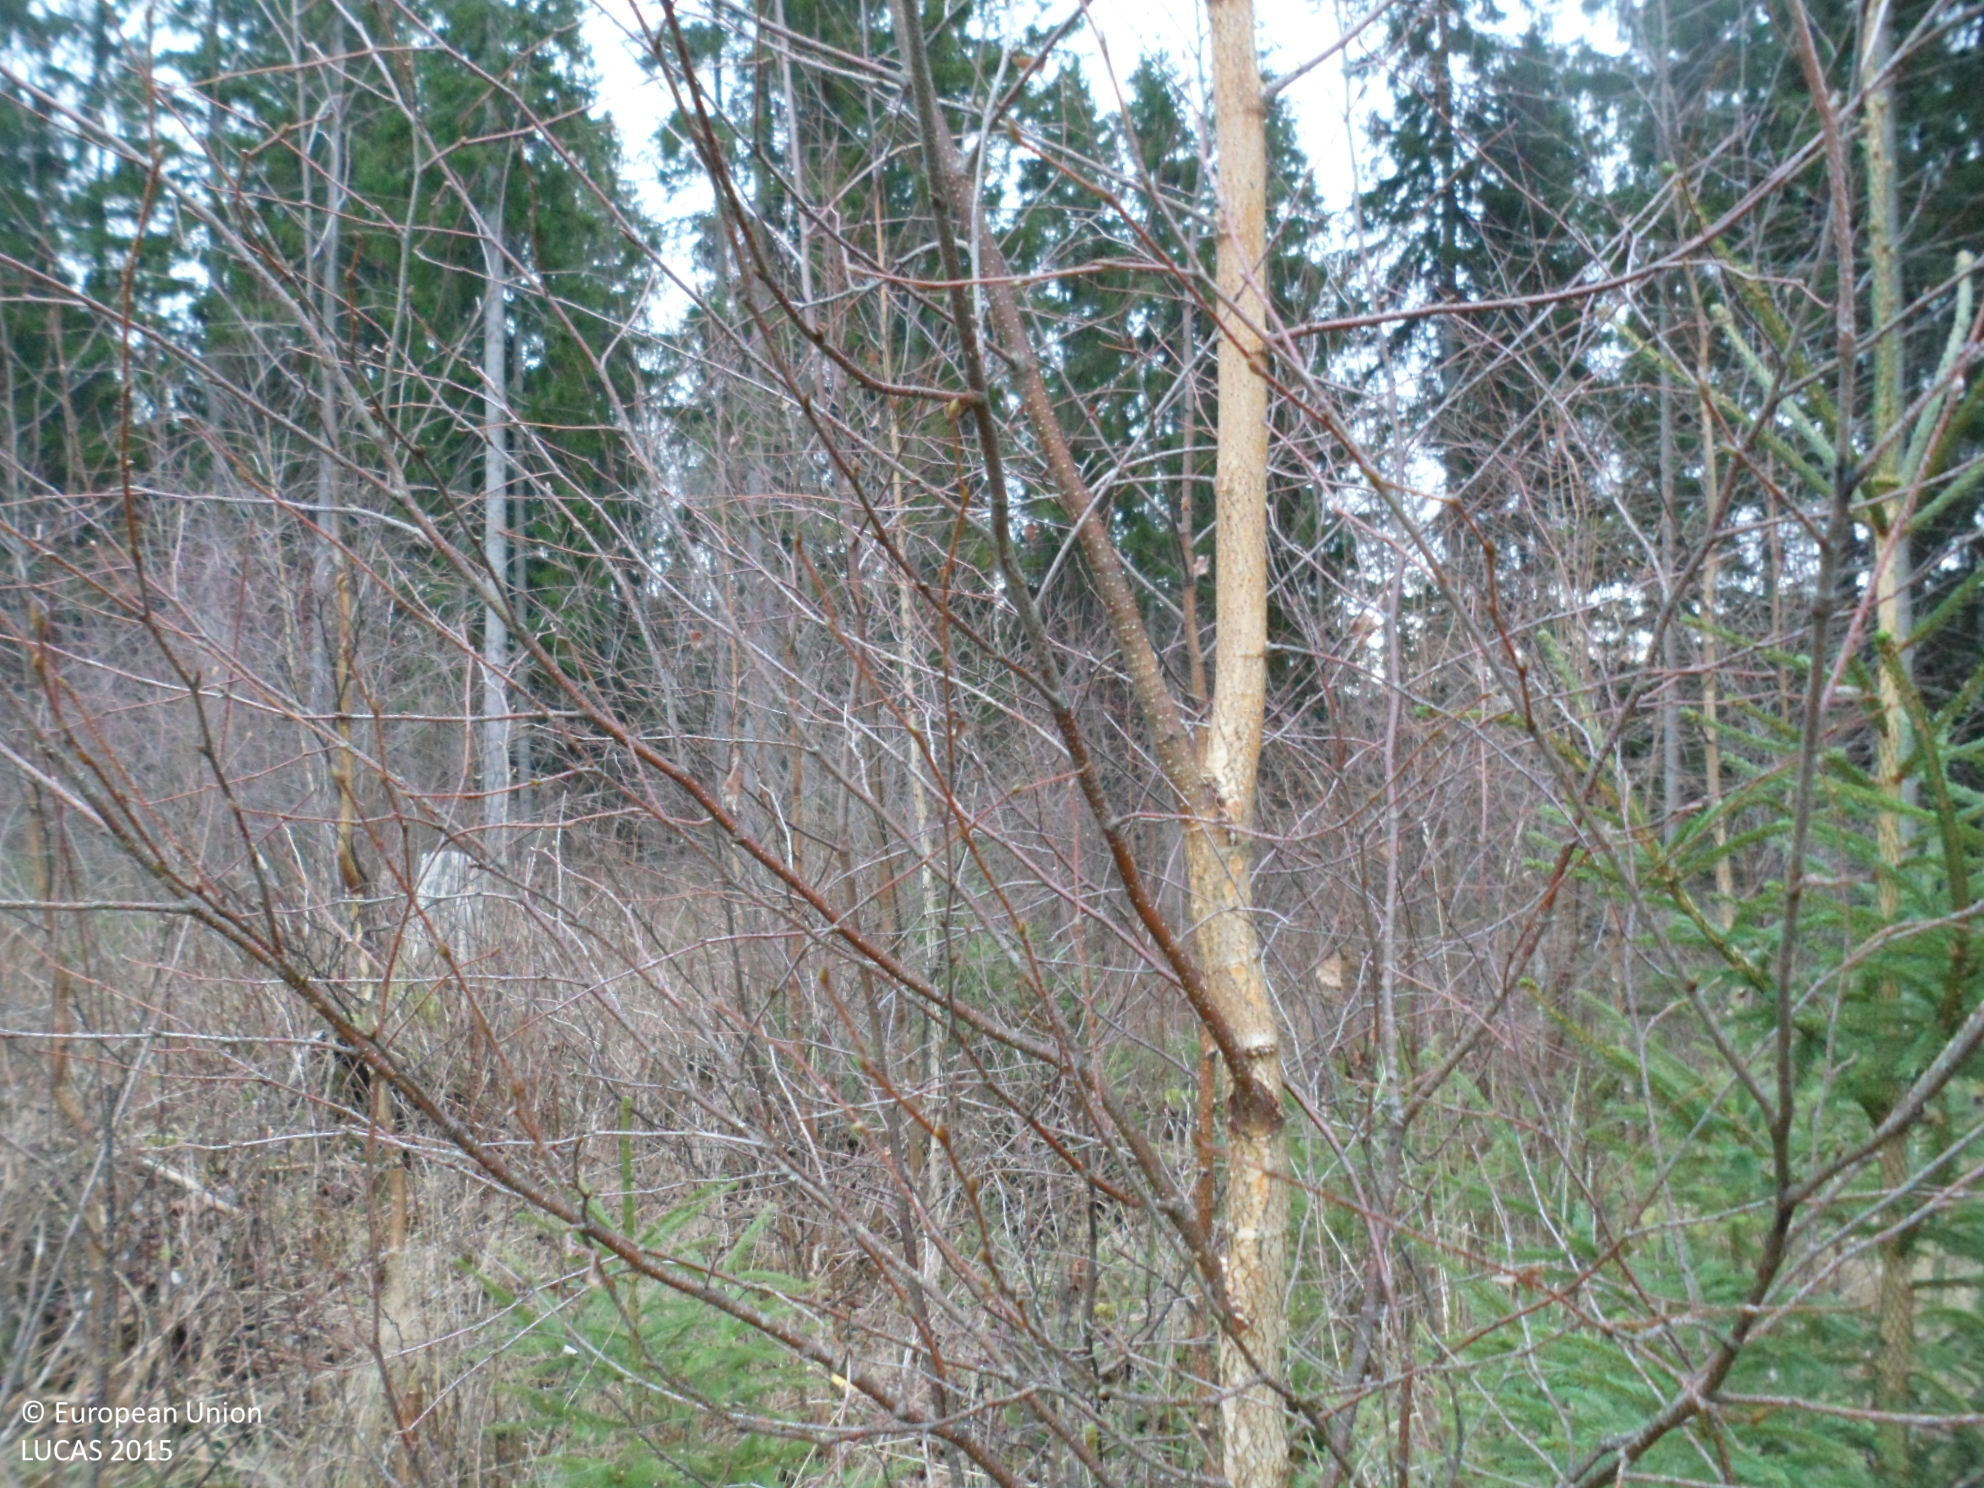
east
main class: Woodland
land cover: Spruce dominated mixed woodland
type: boreal forest
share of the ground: 25 - 50 %
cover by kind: shrubs 30 %, herbaceous plants 30 %, broadleaved forest trees 25 %, coniferous forest trees 10 %, lichens and mosses 5 %
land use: Forestry
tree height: < 5 m
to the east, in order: Spruce dominated mixed woodland; Spruce dominated coniferous woodland; Groves; Inland marshes; Shrubland with sparse tree cover; Spruce dominated mixed woodland; Spruce dominated coniferous woodland
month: November
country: SE
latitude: 57.1486
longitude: 15.5679
